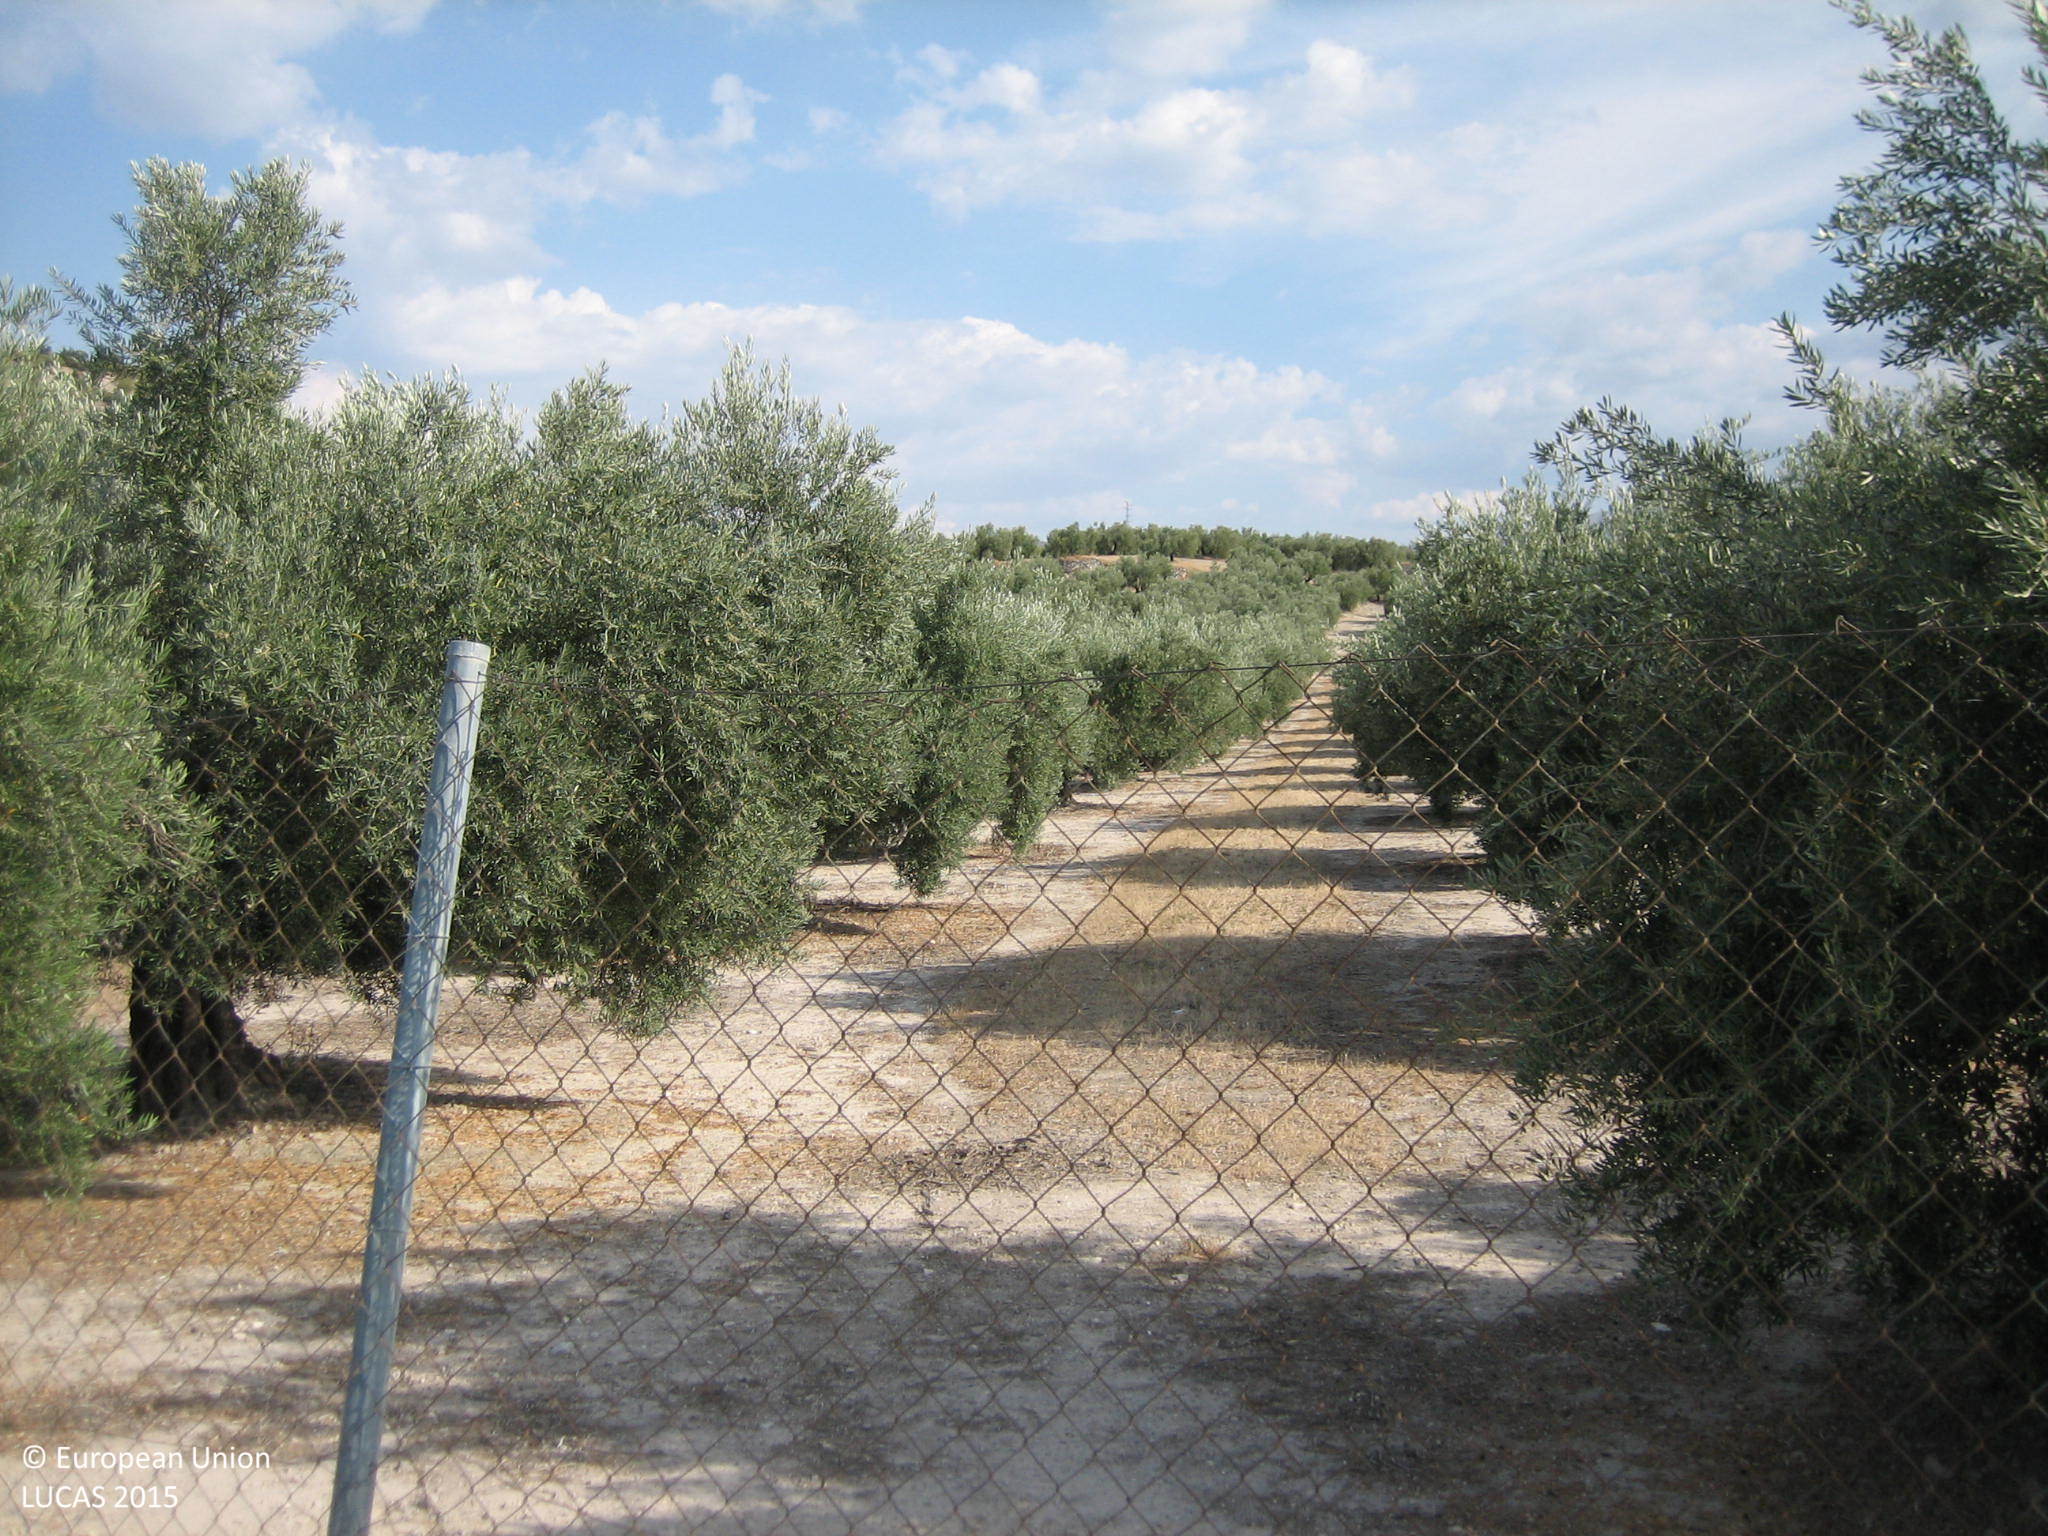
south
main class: Cropland
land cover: Olive groves
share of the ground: 25 - 50 %
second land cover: Other bare soil
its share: > 75 %
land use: Agriculture (excluding fallow land and kitchen gardens)
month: June
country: ES
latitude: 37.7688
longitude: -3.7708
